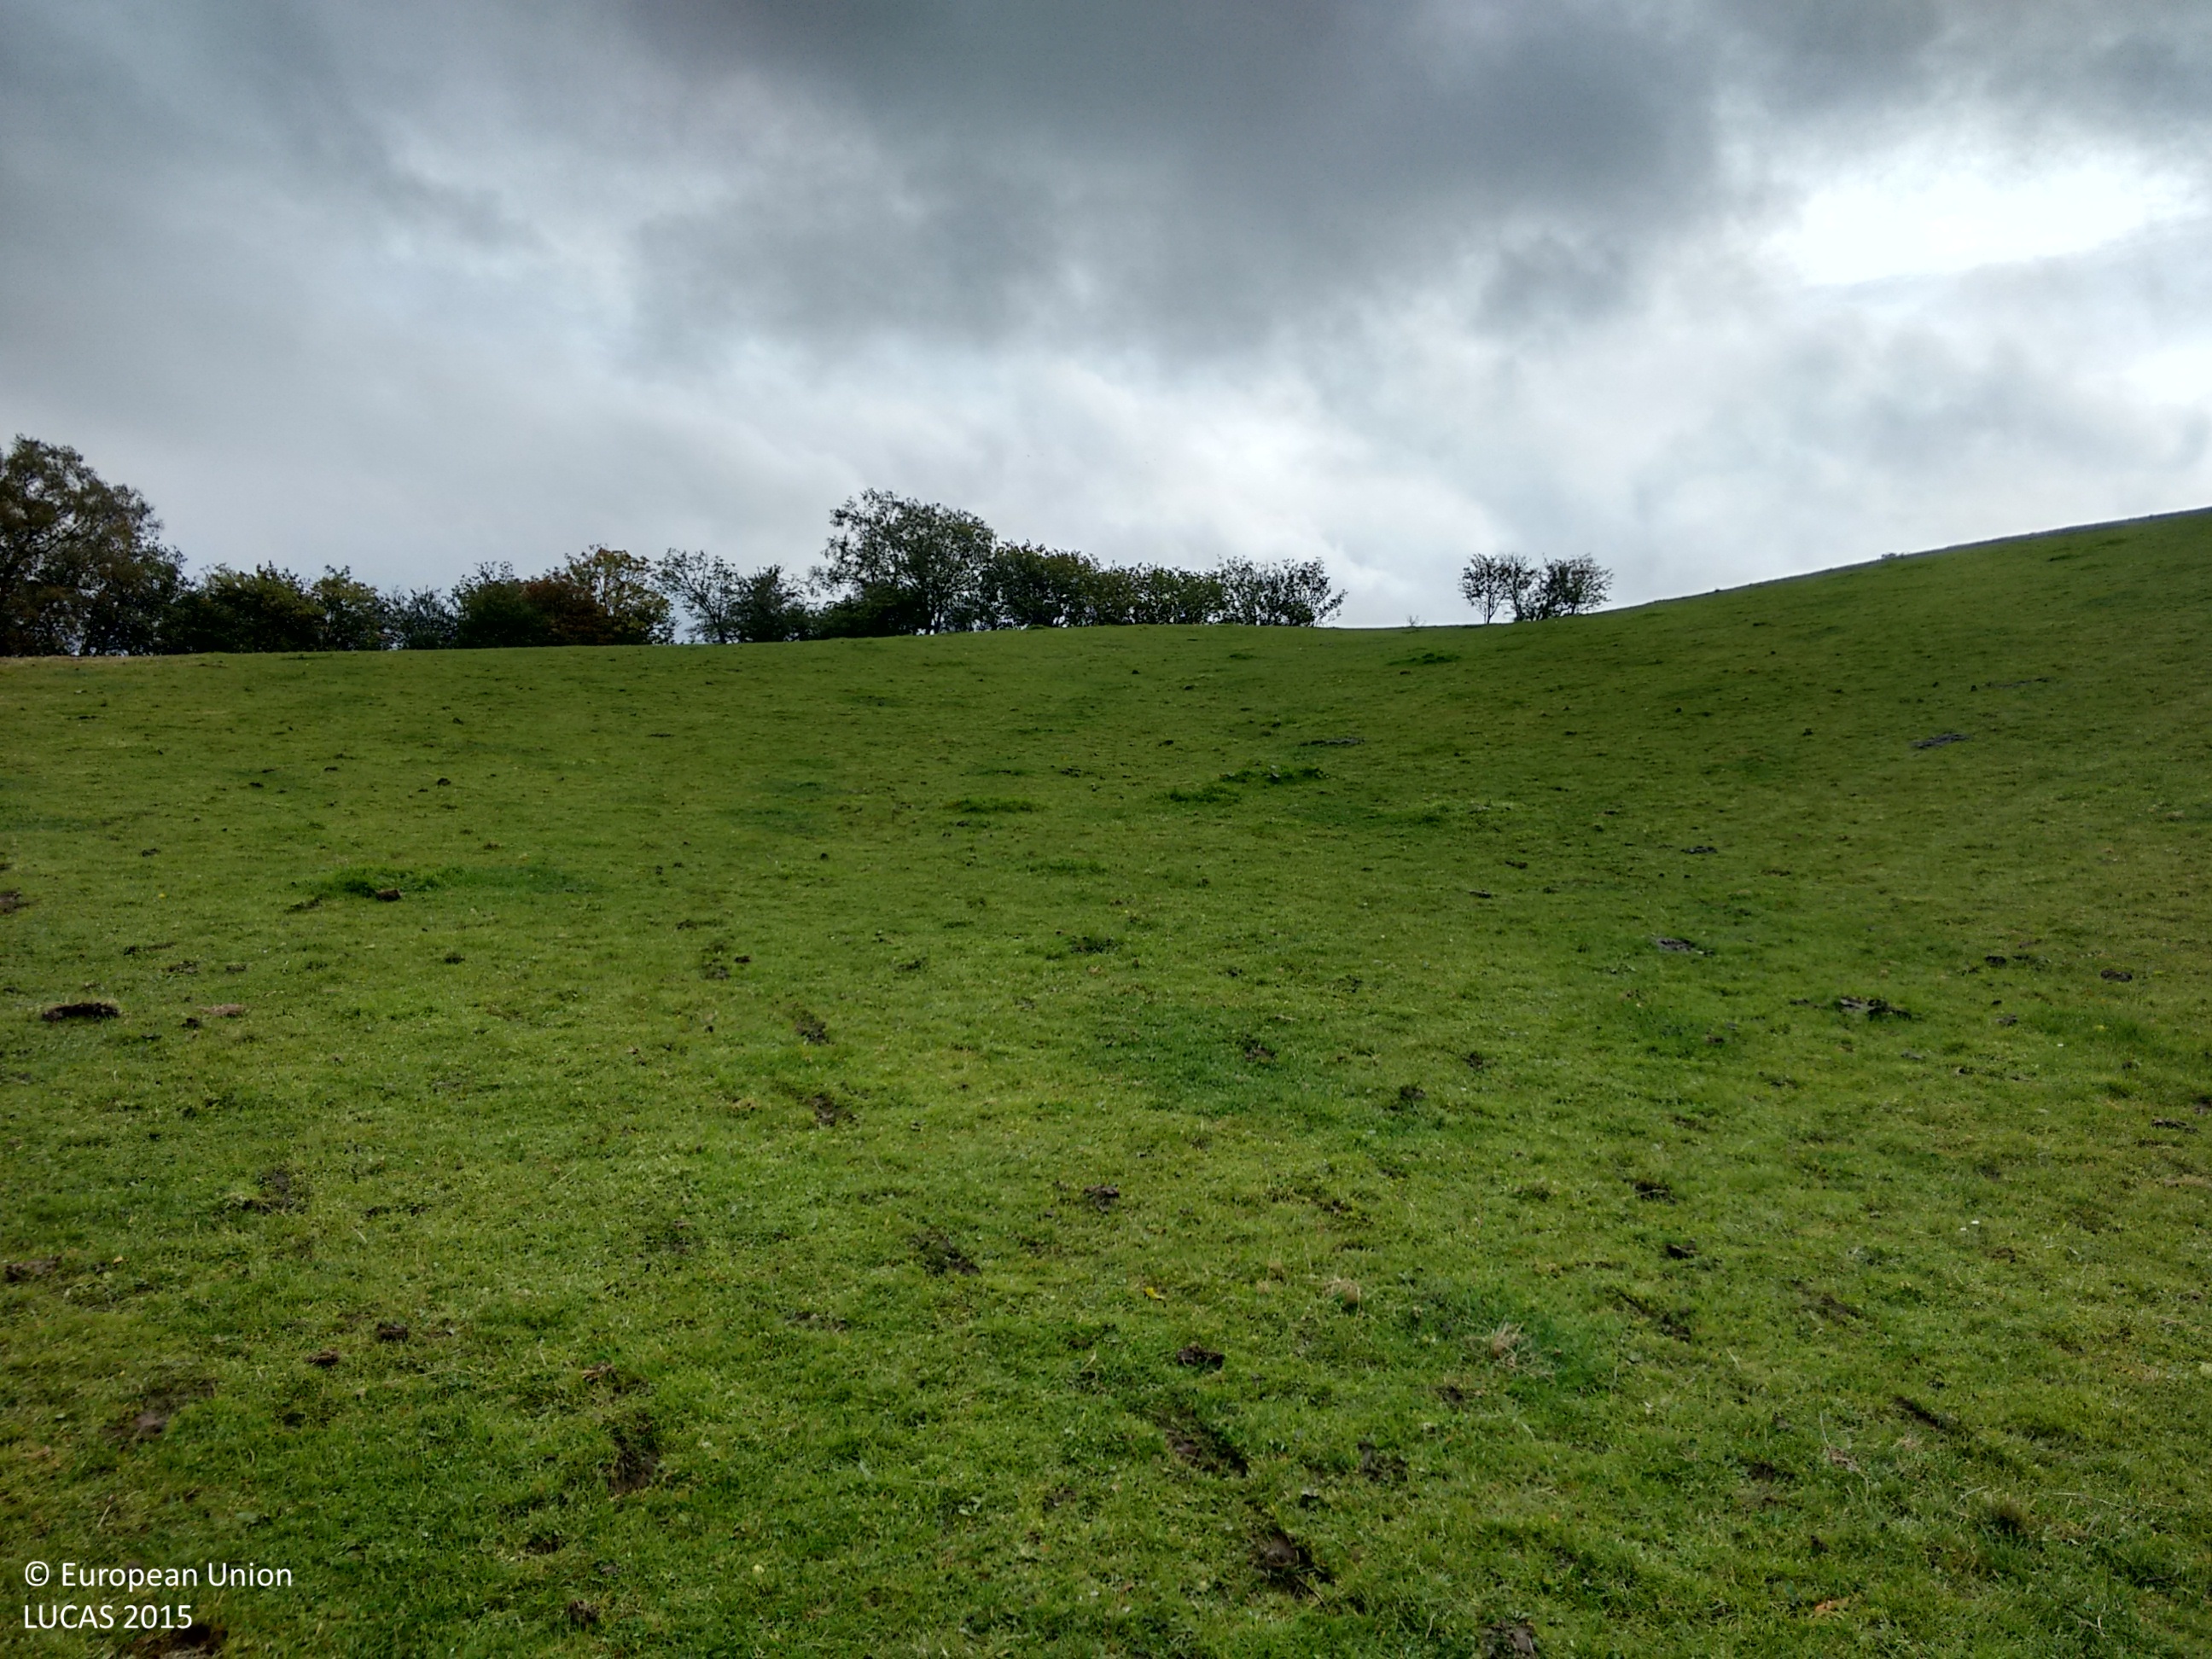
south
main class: Grassland
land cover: Grassland without tree/shrub cover
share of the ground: > 75 %
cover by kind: herbaceous plants 100 %
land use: Agriculture (excluding fallow land and kitchen gardens)
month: October
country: GB
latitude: 52.3275
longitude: -3.2116
